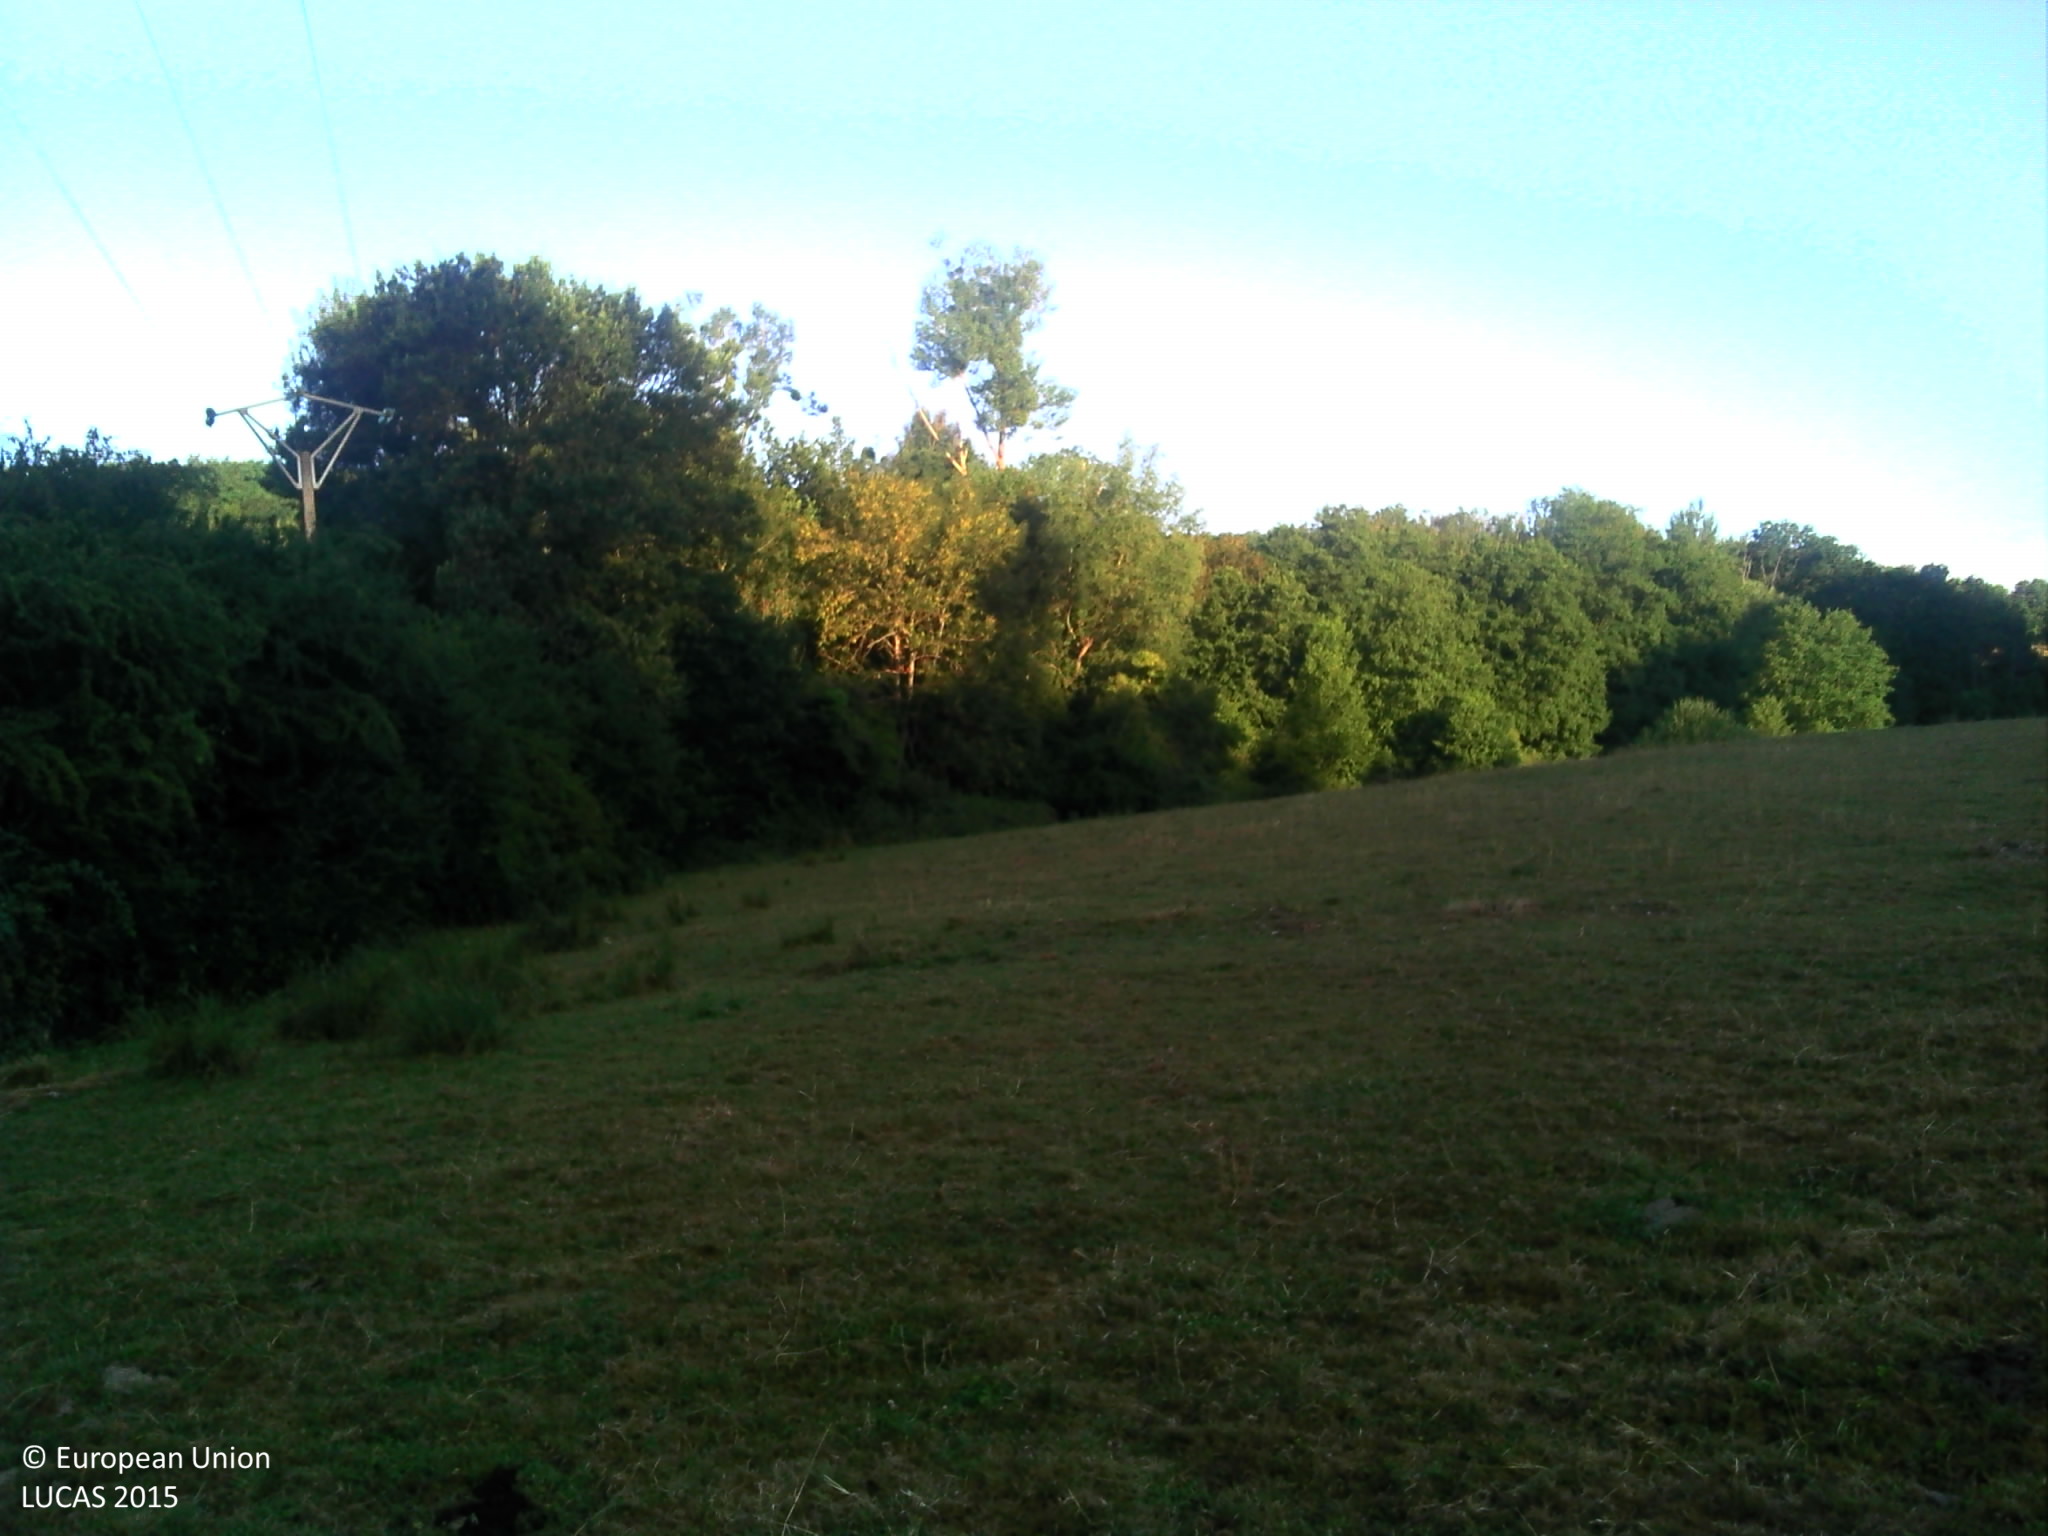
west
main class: Grassland
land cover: Grassland without tree/shrub cover
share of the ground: > 75 %
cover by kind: herbaceous plants 100 %
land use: Agriculture (excluding fallow land and kitchen gardens)
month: July
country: FR
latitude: 47.8747
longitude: 5.3873
